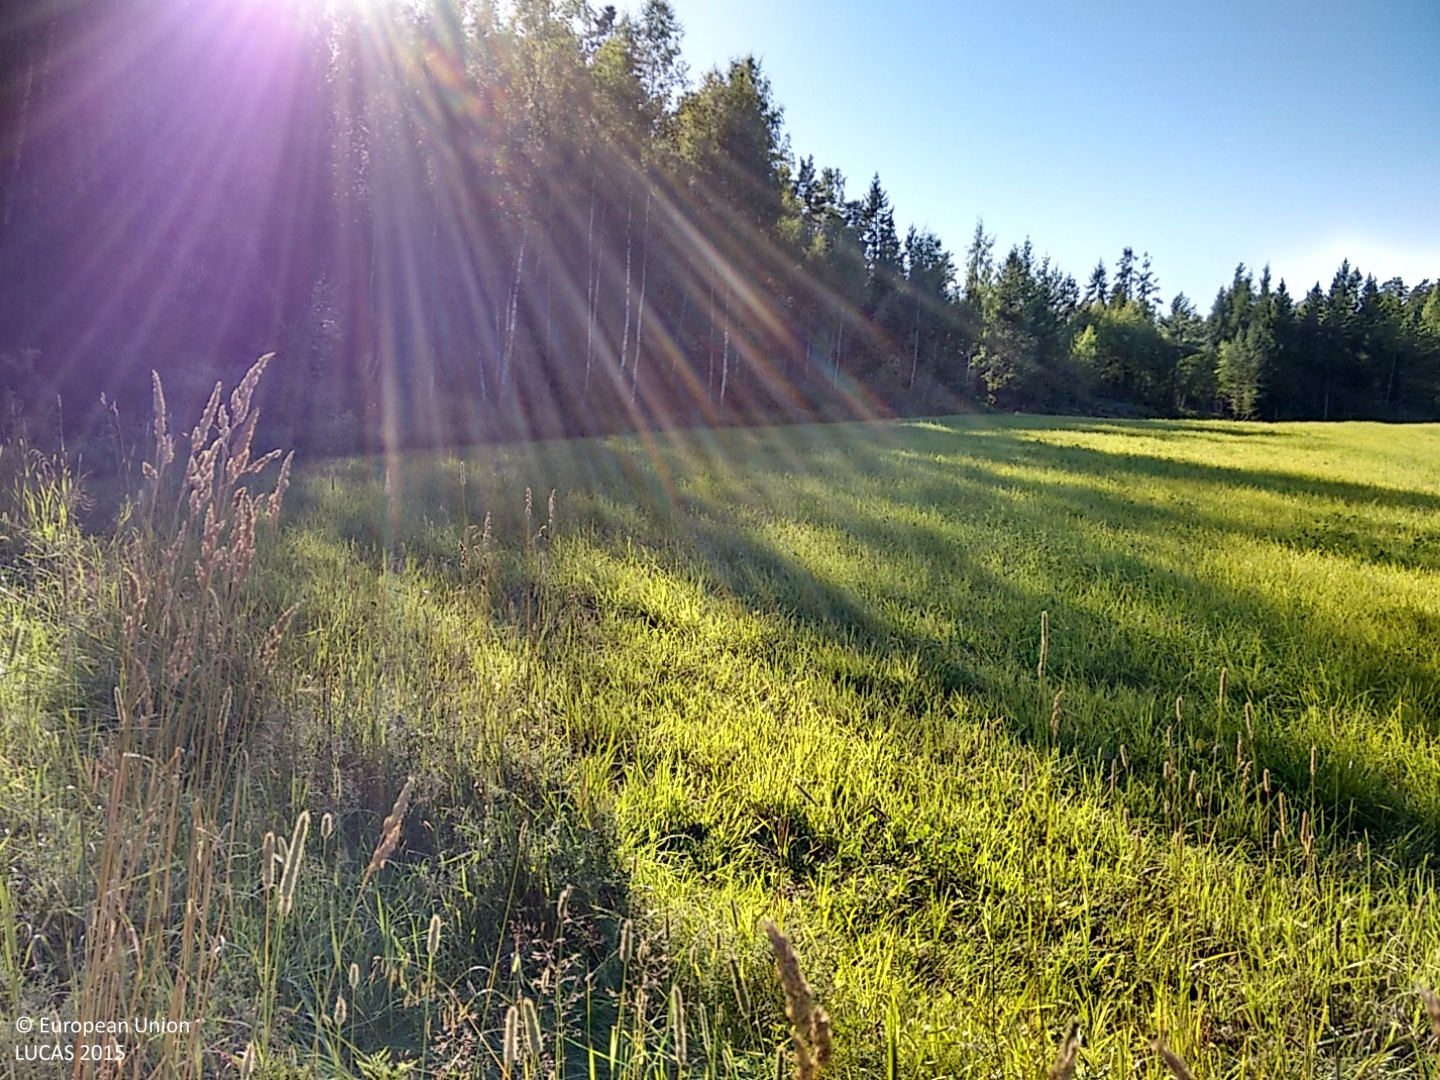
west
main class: Grassland
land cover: Spontaneously vegetated surfaces
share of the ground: > 75 %
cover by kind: herbaceous plants 100 %
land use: Semi-natural and natural areas not in use
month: August
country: FI
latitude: 60.3546
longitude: 19.9558
